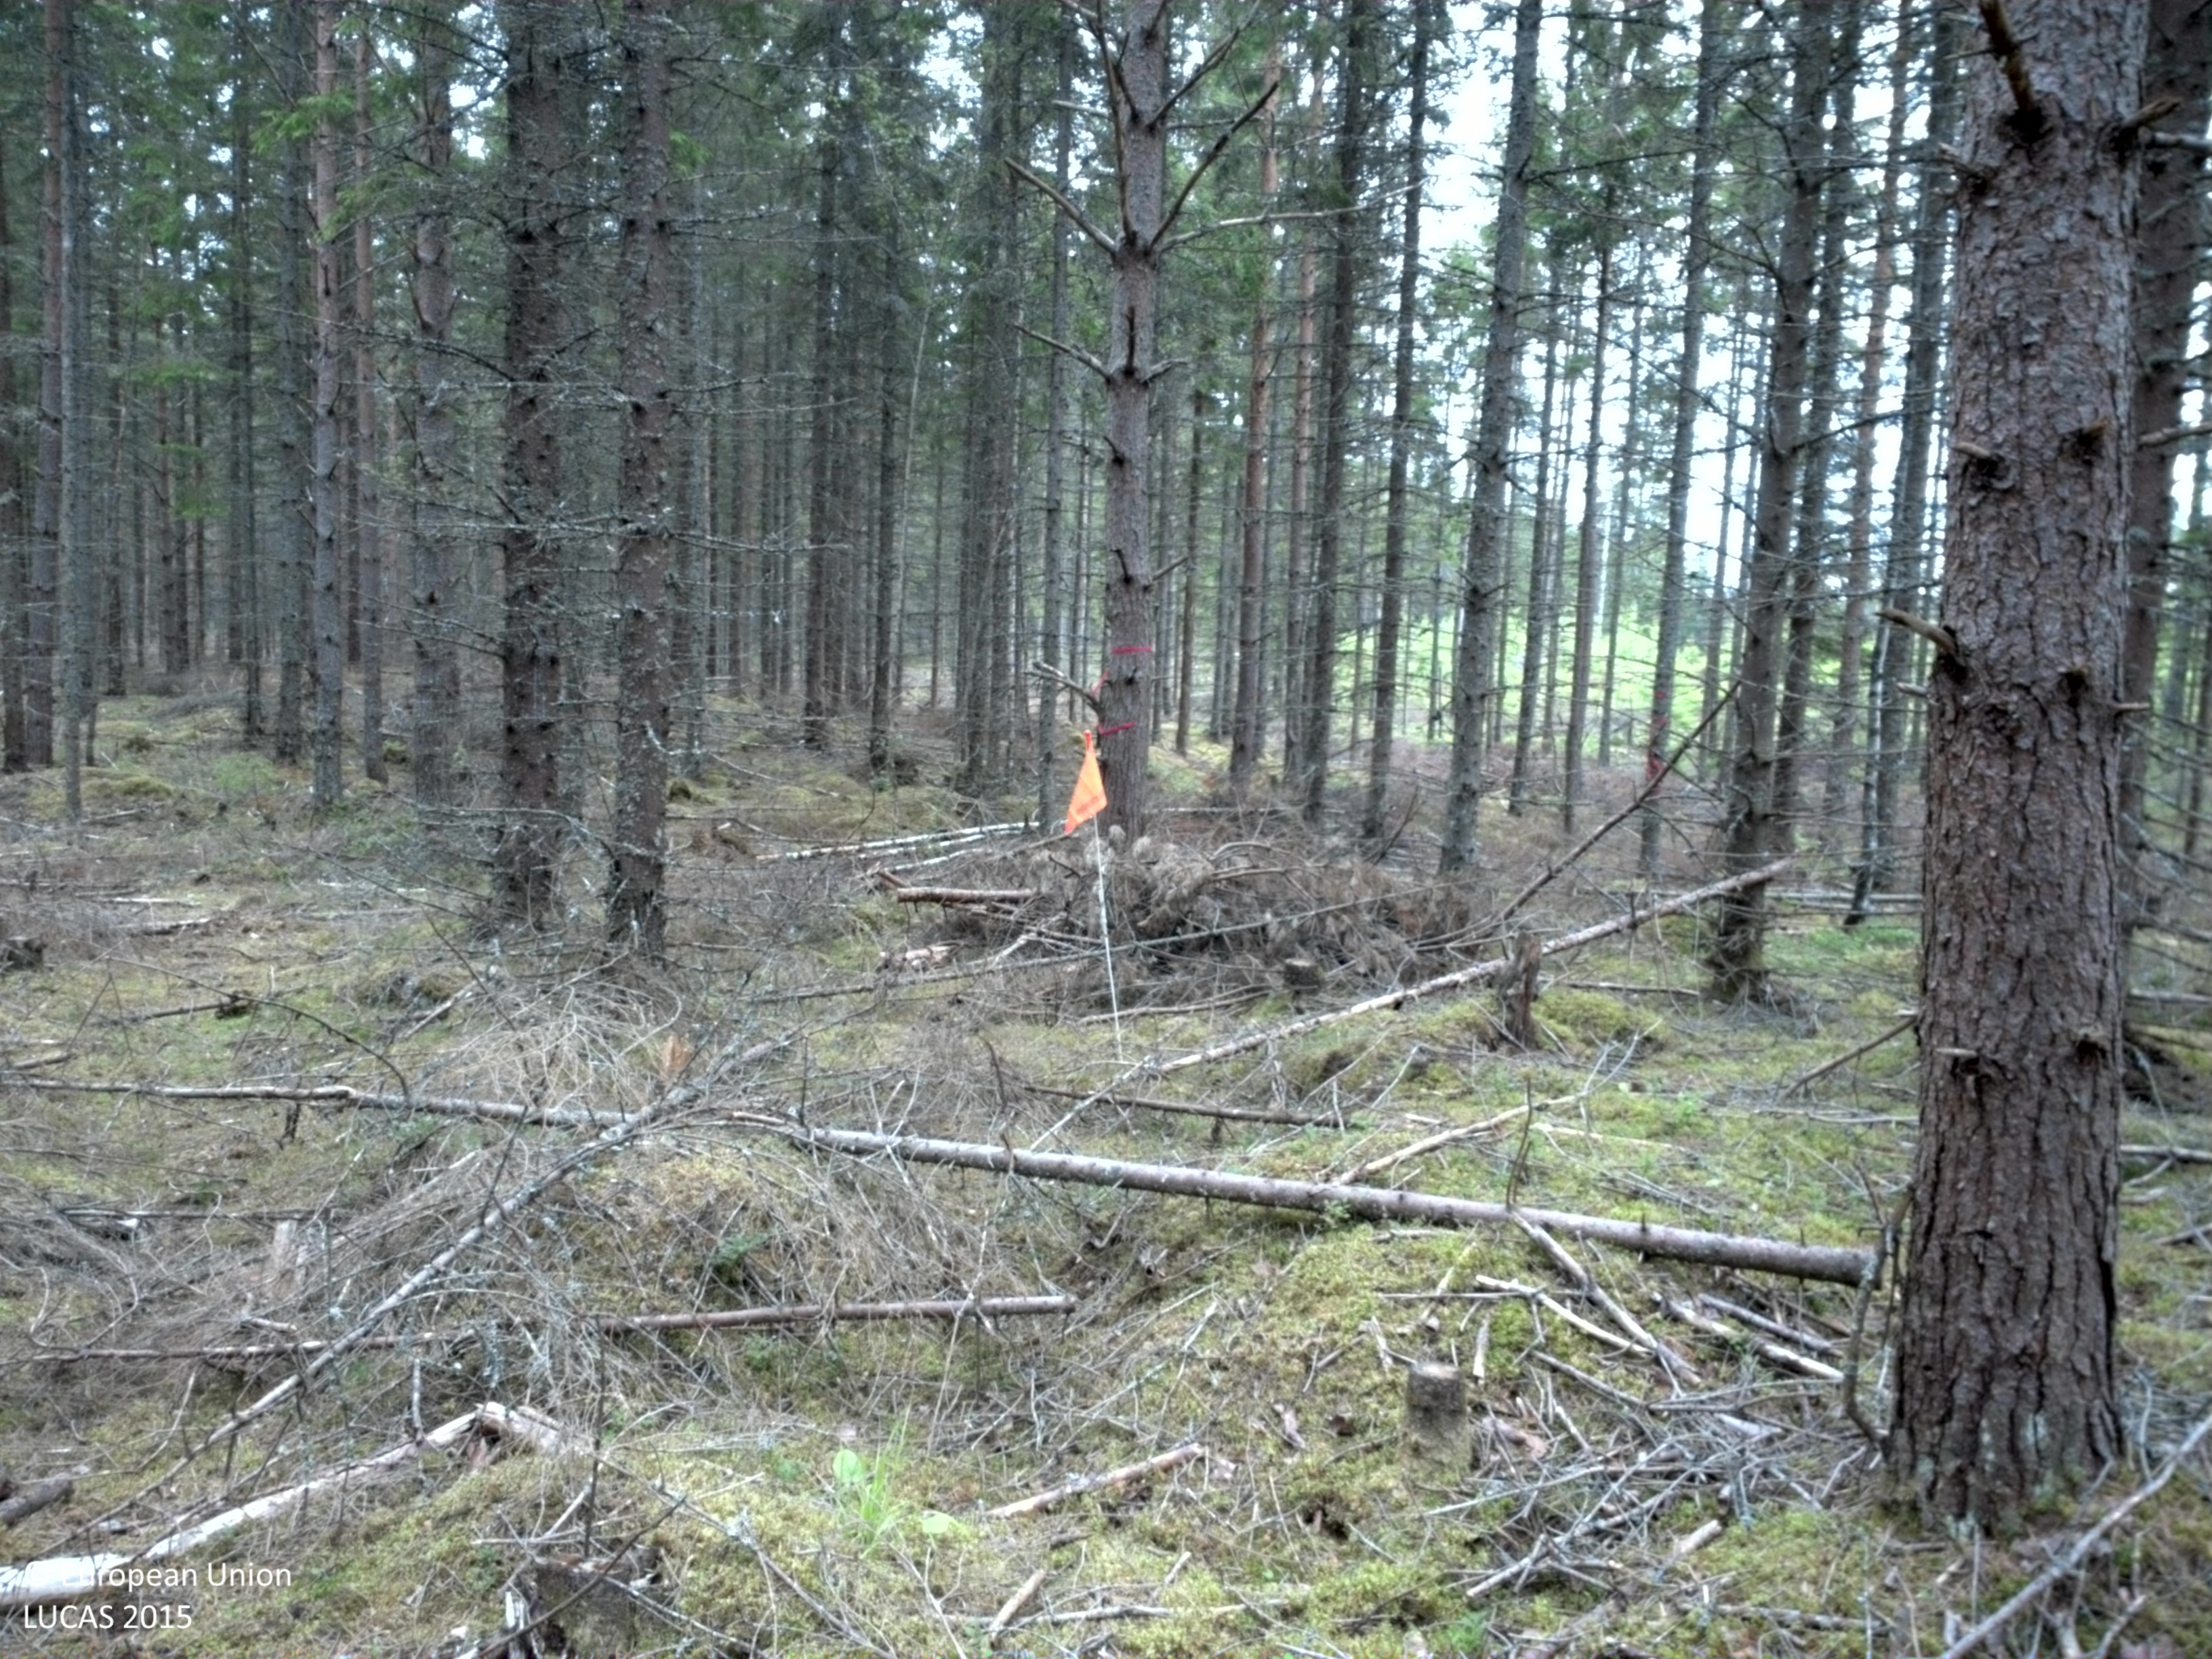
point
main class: Woodland
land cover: Spruce dominated coniferous woodland
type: boreal forest
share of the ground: 25 - 50 %
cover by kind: lichens and mosses 50 %, coniferous forest trees 45 %, herbaceous plants 5 %
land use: Forestry
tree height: > 5 m
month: July
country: SE
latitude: 58.9171
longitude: 14.5596
